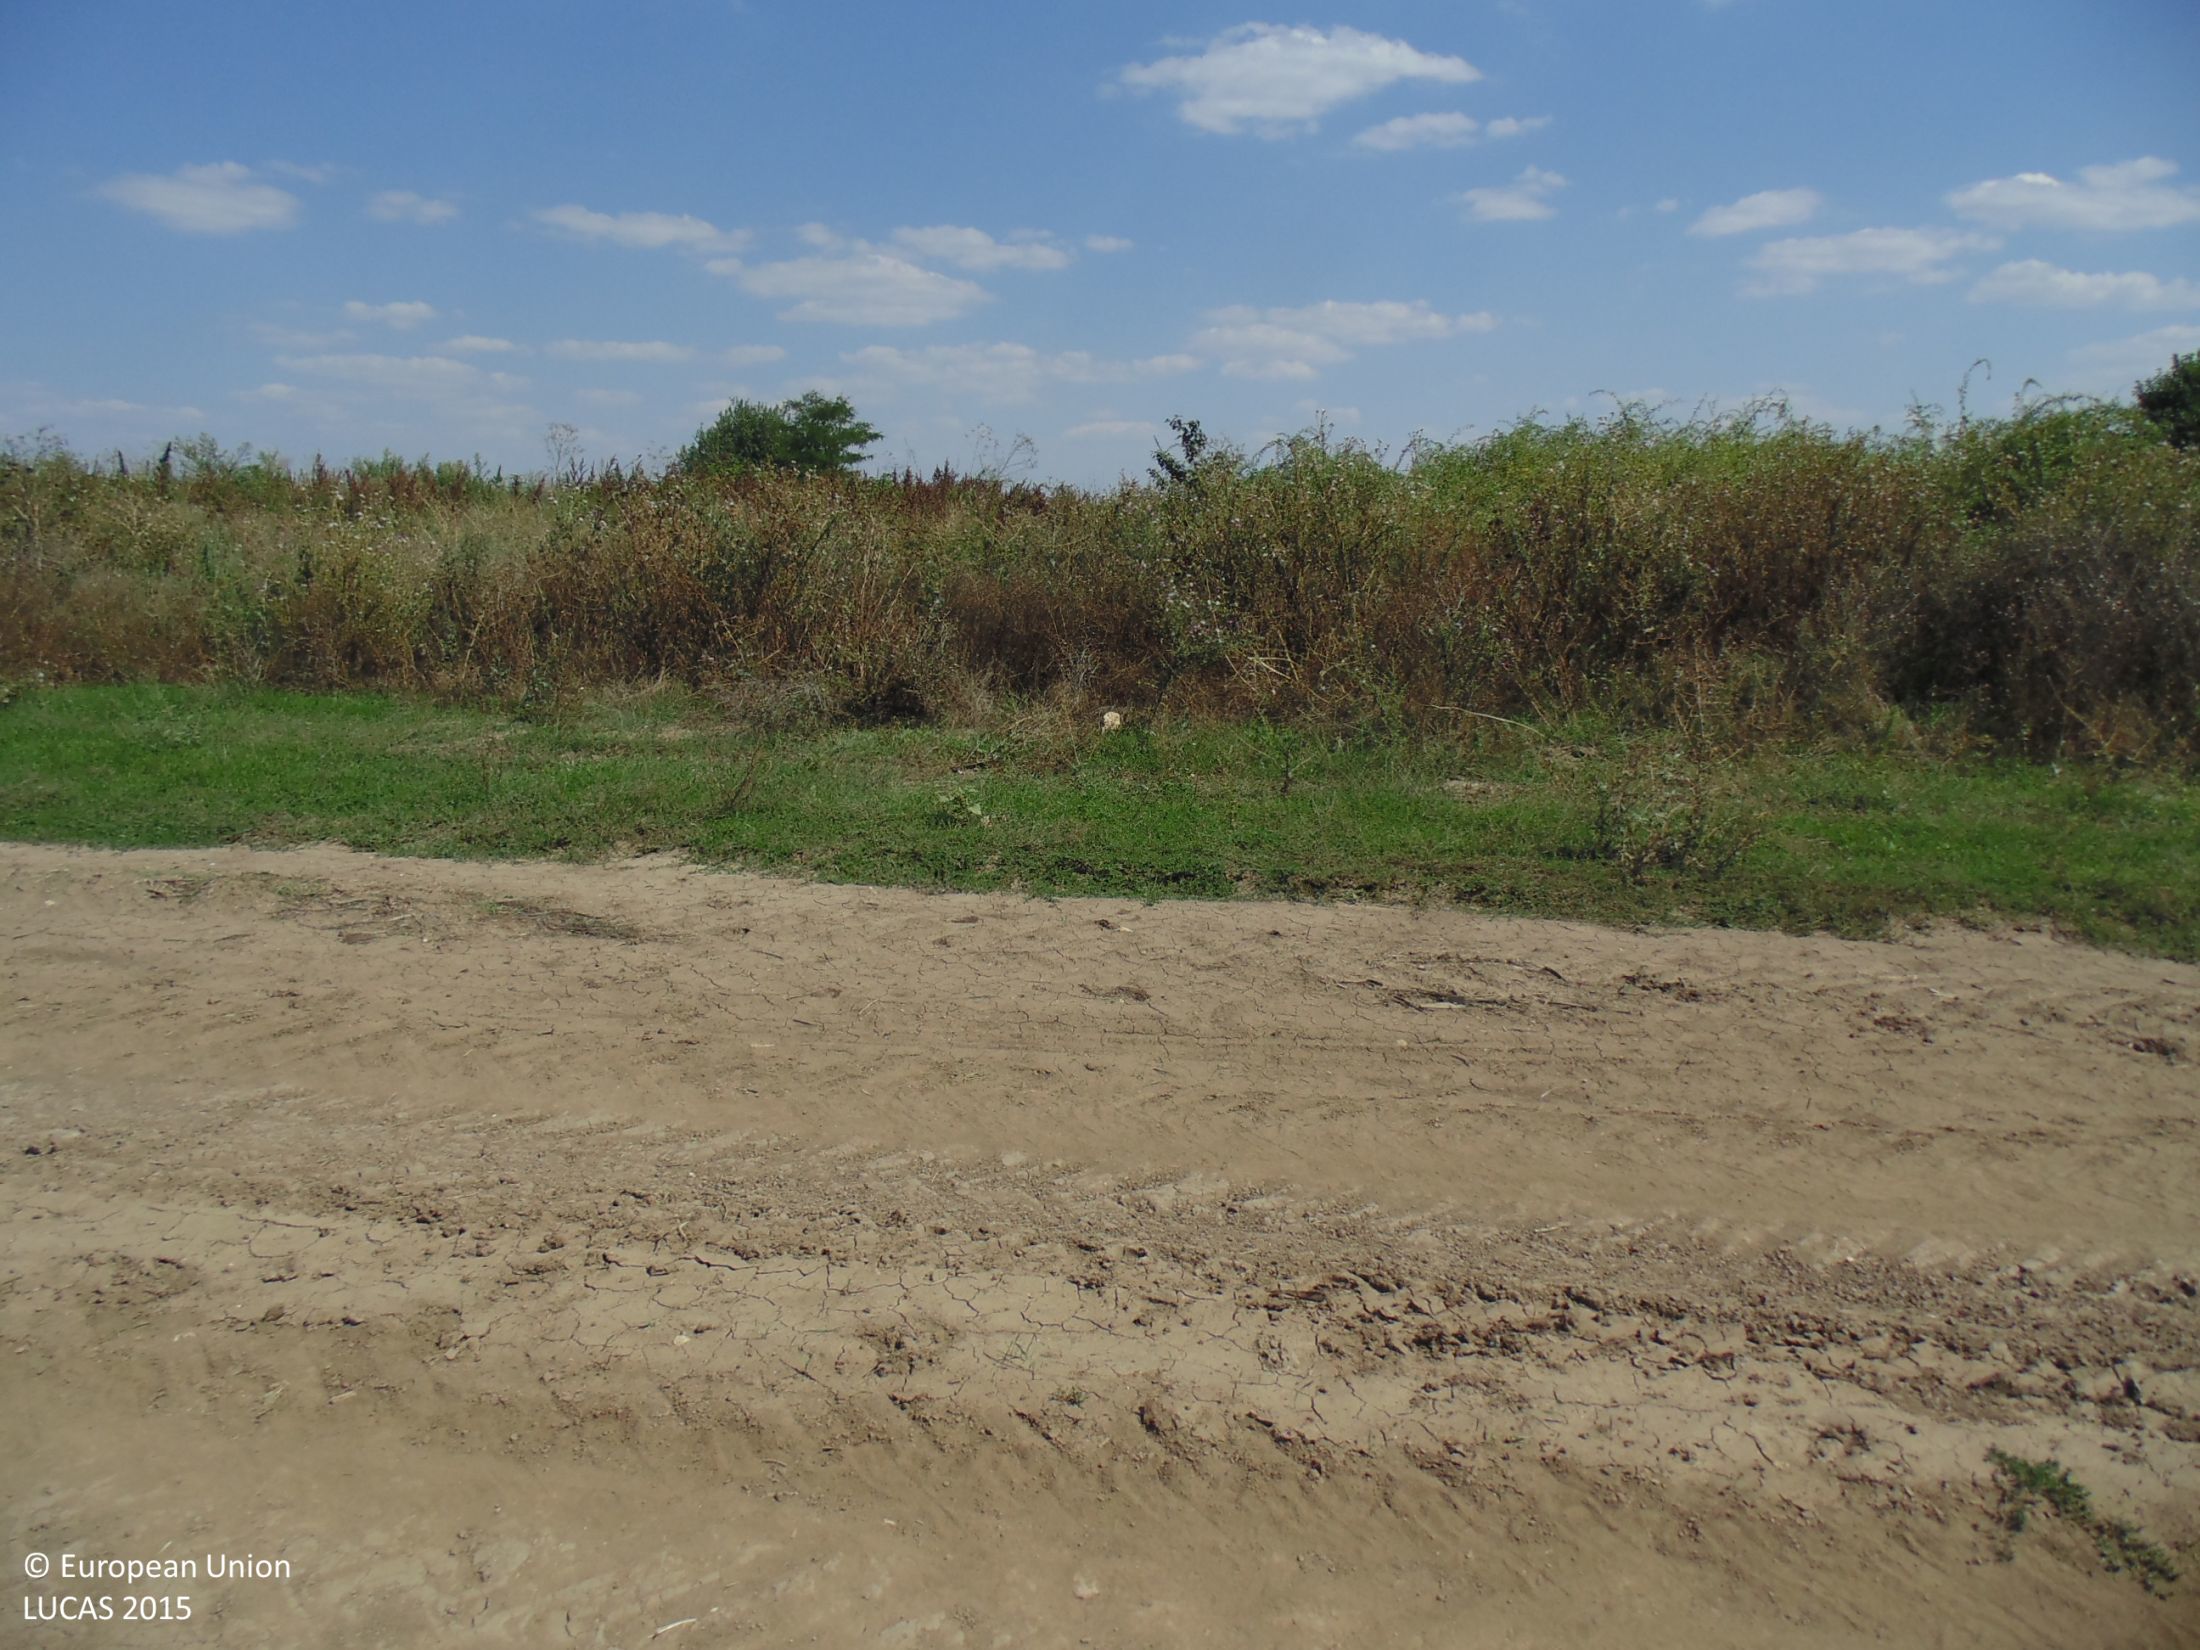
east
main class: Cropland
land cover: Common wheat
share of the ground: 10 - 25 %
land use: Agriculture (excluding fallow land and kitchen gardens)
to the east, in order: Common wheat; Grass margins; Tracks; Grass margins; Spontaneously vegetated surfaces; Tracks; Spontaneously vegetated surfaces; Lucerne; Grass margins; Maize; Grass margins; Maize
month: August
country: BG
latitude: 43.6963
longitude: 27.2875
